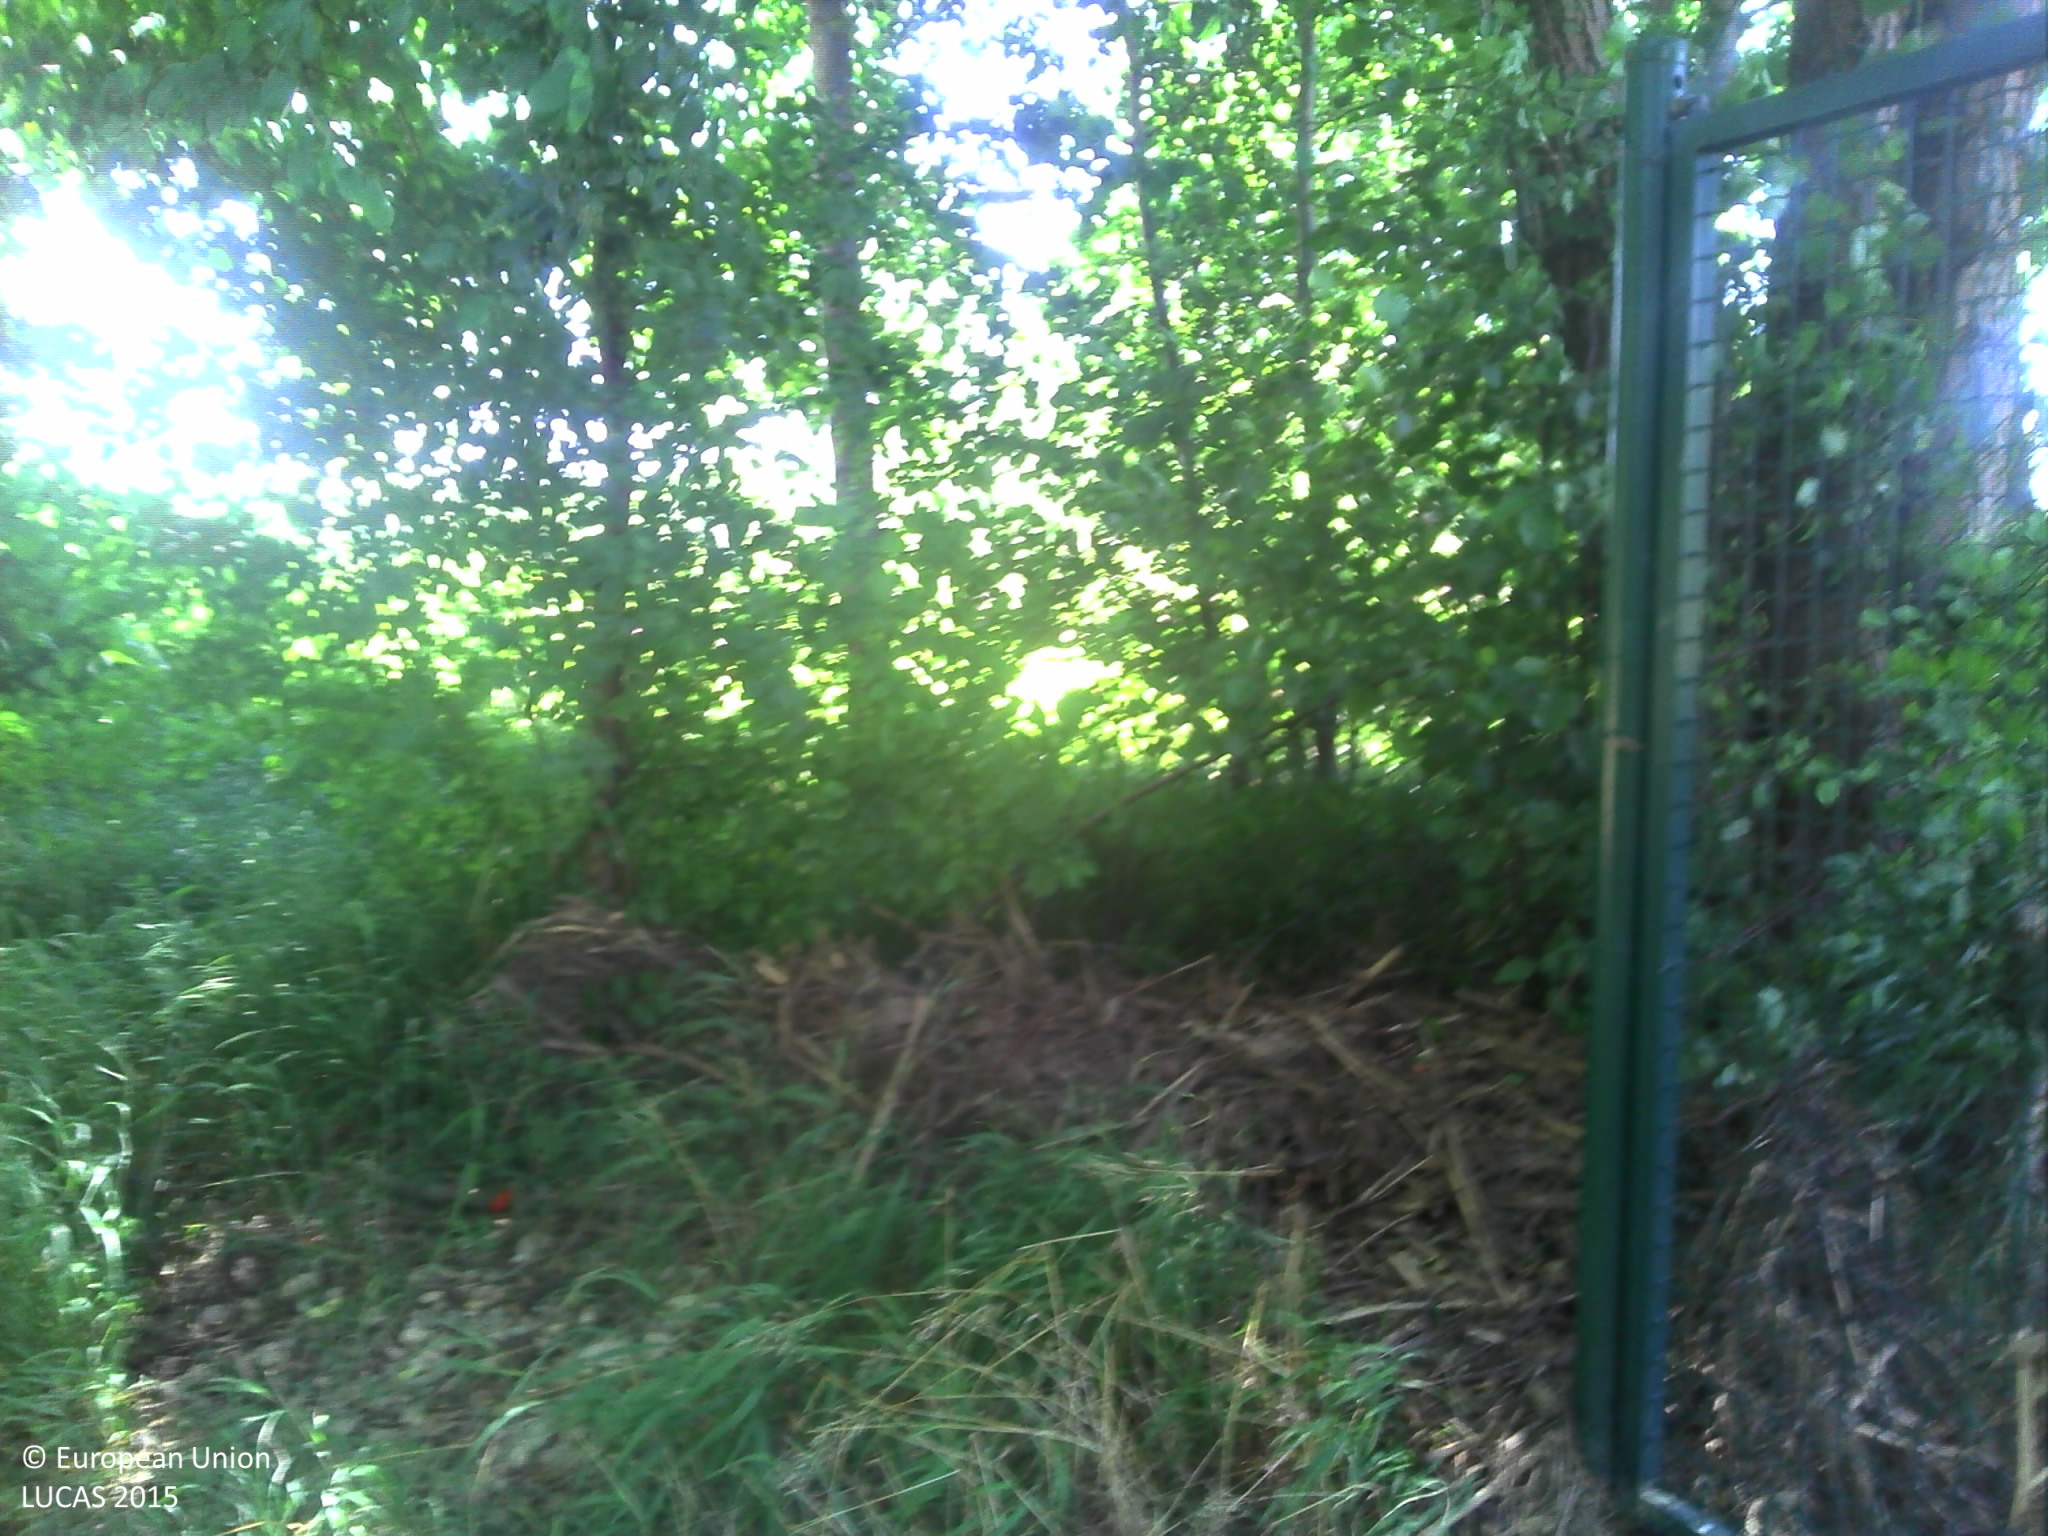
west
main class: Woodland
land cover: Broadleaved woodland
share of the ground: > 75 %
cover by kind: broadleaved forest trees 75 %, herbaceous plants 10 %, unconsolidated bare surface 10 %, shrubs 5 %
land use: Semi-natural and natural areas not in use
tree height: > 5 m
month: July
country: FR
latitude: 45.5793
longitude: 4.8906
